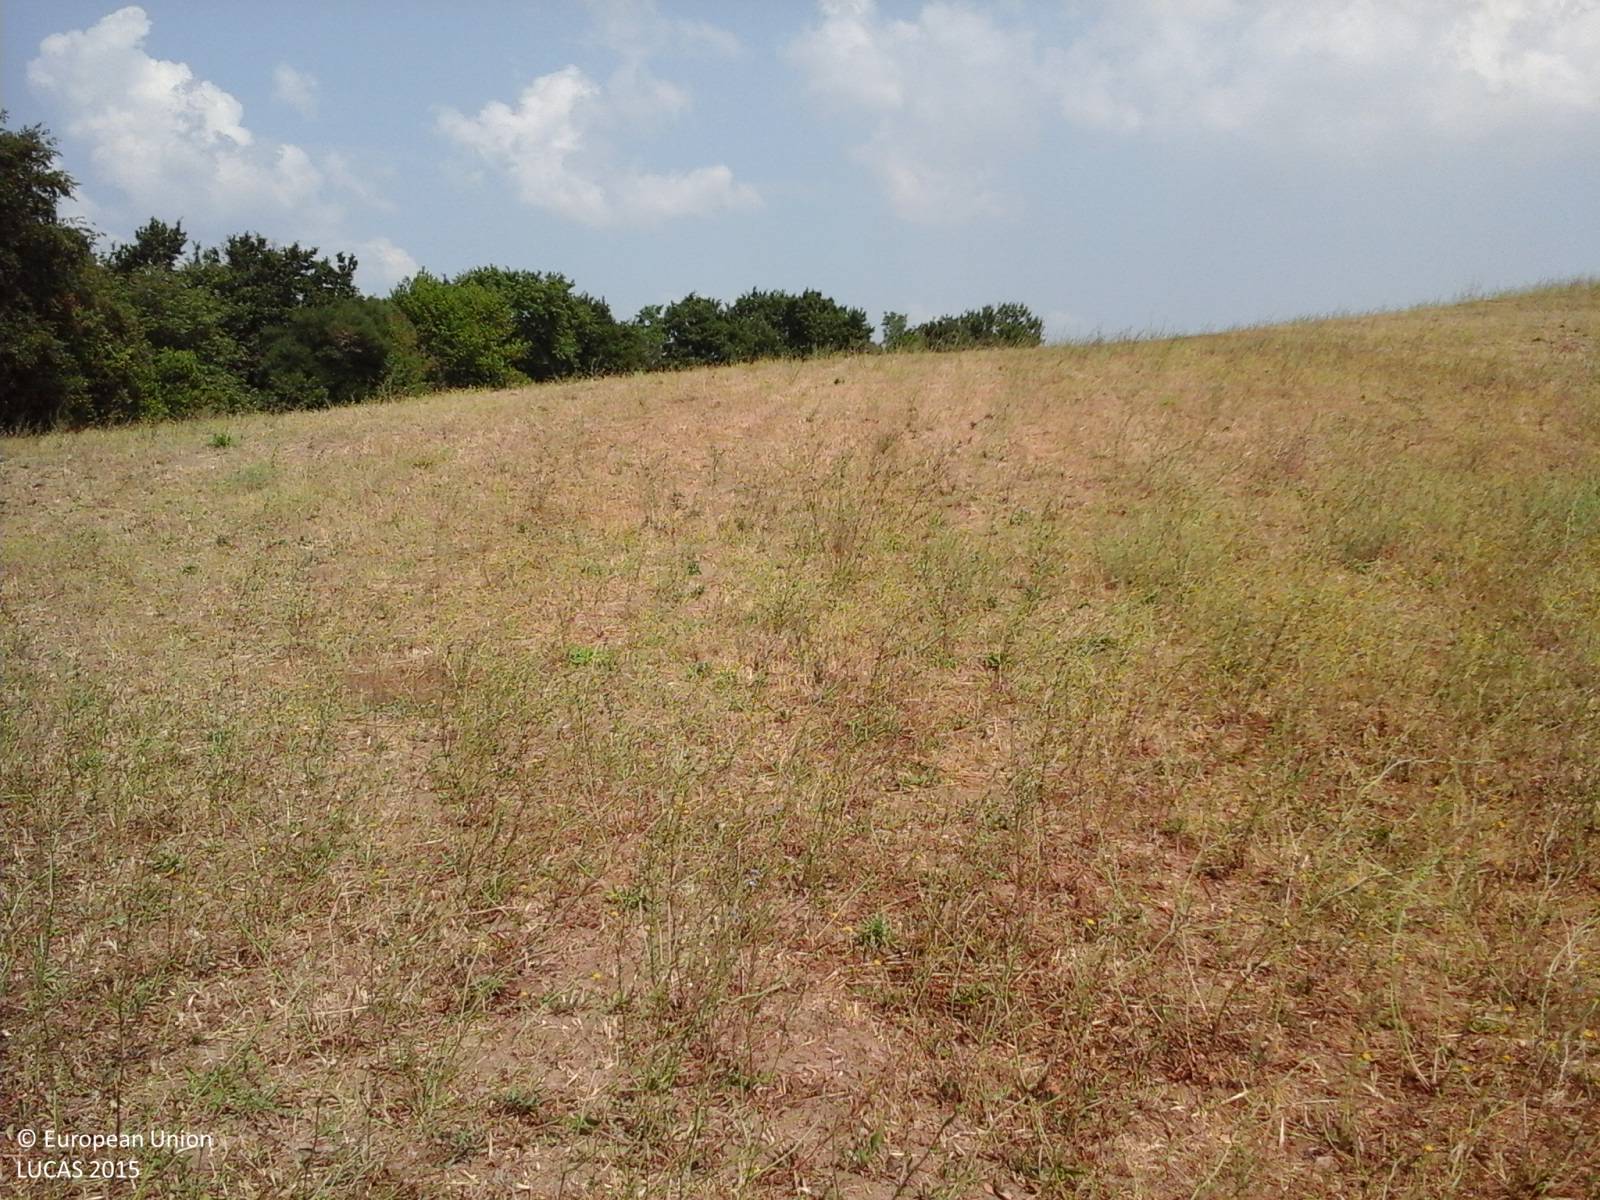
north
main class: Cropland
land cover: Mixed cereals for fodder
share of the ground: > 75 %
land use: Agriculture (excluding fallow land and kitchen gardens)
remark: Harvested field
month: July
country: IT
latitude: 41.9790
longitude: 12.2245
